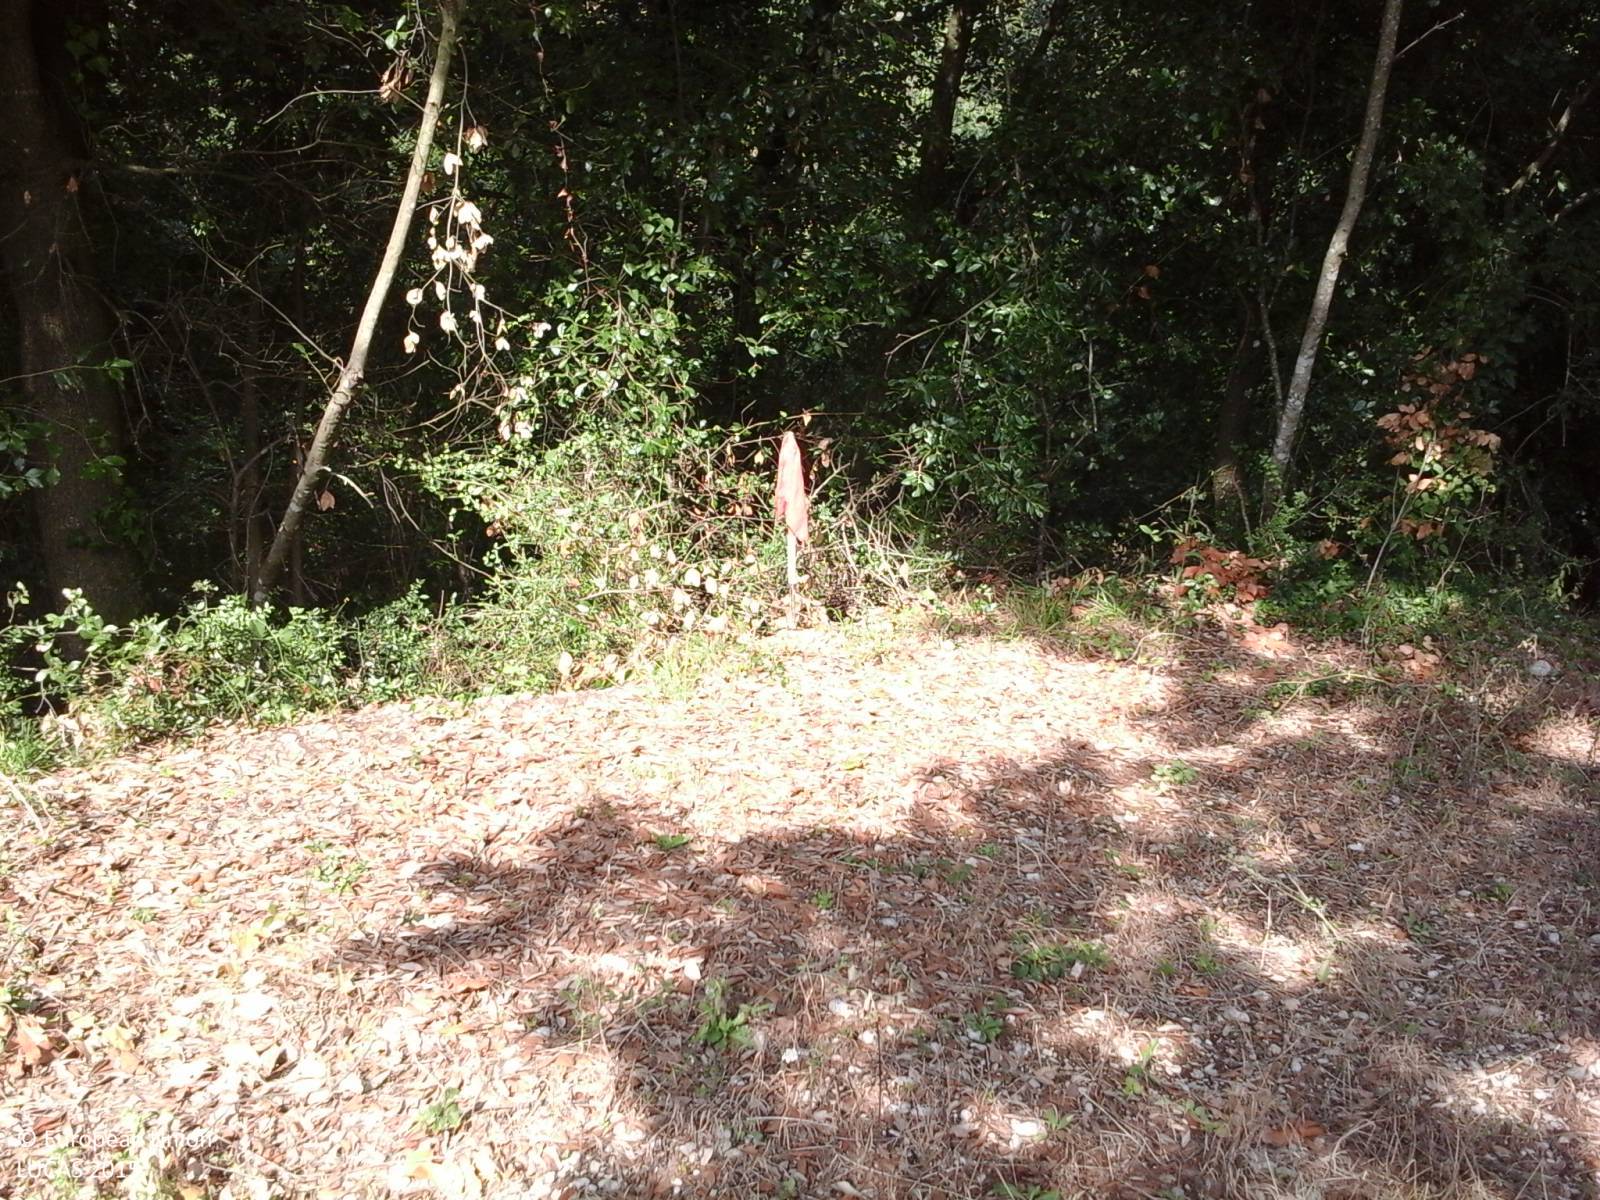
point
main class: Grassland
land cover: Grassland without tree/shrub cover
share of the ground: > 75 %
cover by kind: herbaceous plants 100 %
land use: Agriculture (excluding fallow land and kitchen gardens)
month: August
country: IT
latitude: 41.5378
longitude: 13.1641
